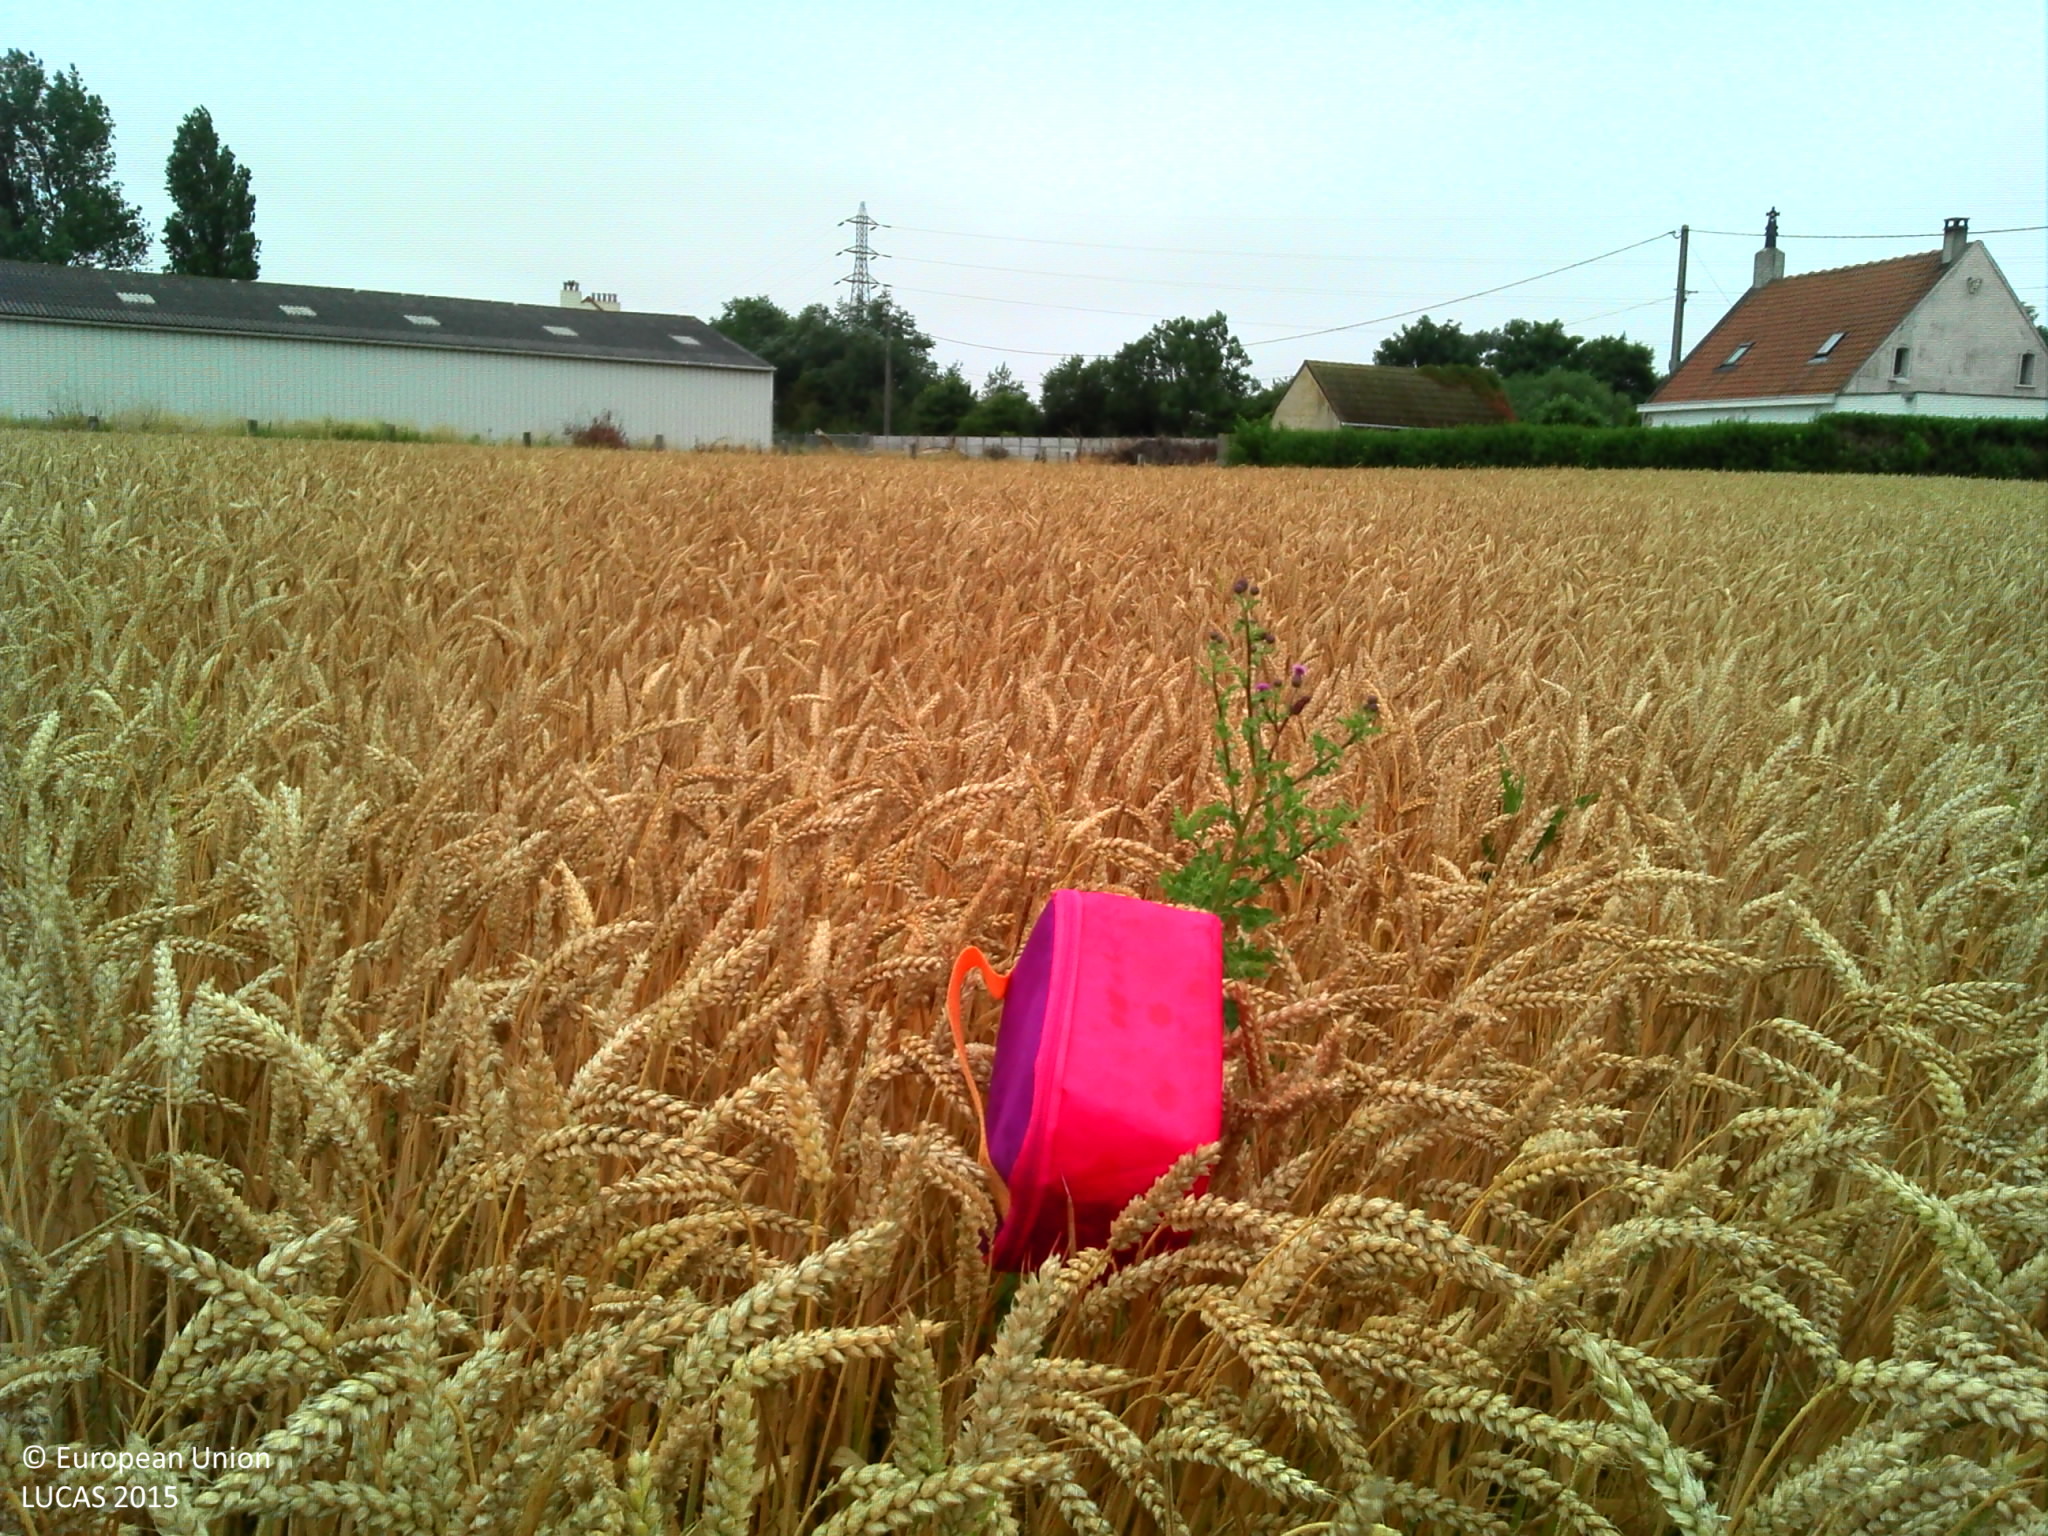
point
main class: Cropland
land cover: Common wheat
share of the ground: > 75 %
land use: Agriculture (excluding fallow land and kitchen gardens)
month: July
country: FR
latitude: 50.9701
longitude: 2.2818
